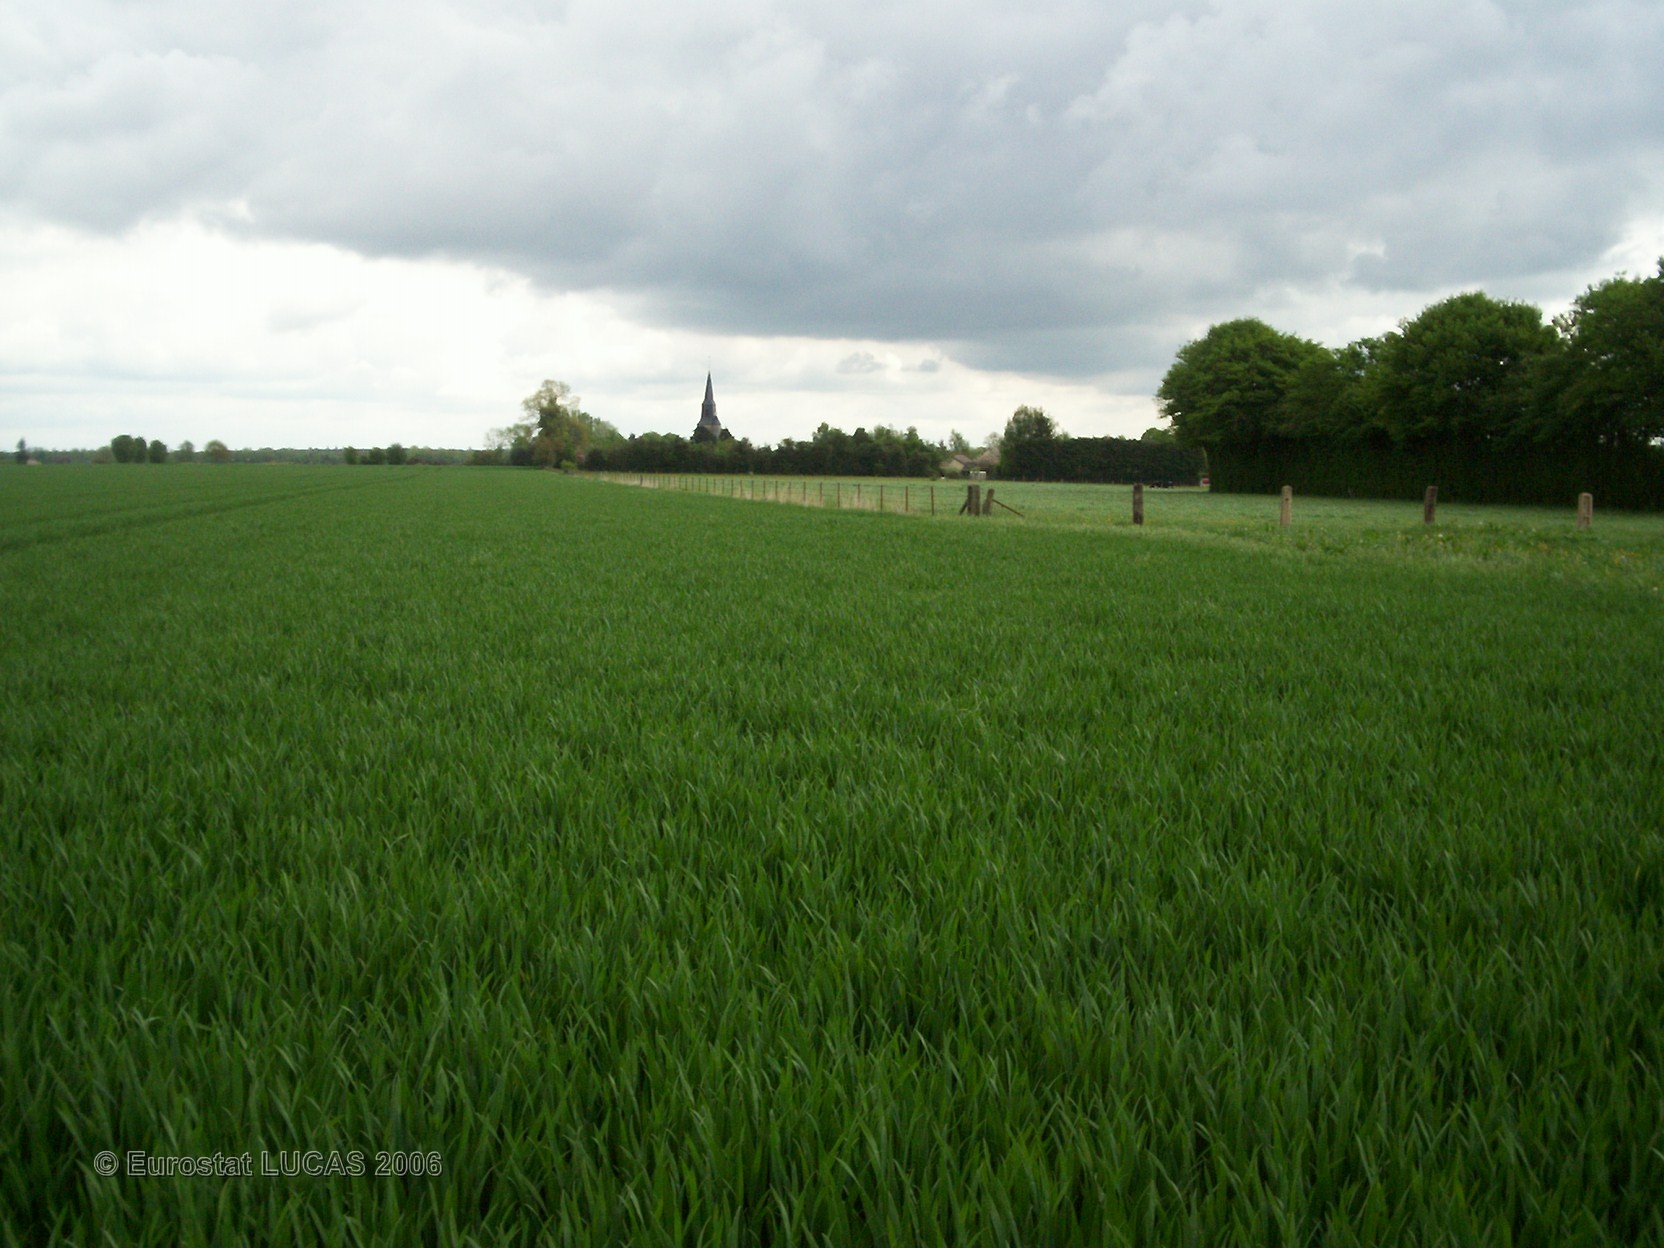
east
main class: Cropland
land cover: Common wheat
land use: Agriculture (excluding fallow land and kitchen gardens)
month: May
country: FR
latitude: 49.0460
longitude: 0.5203
